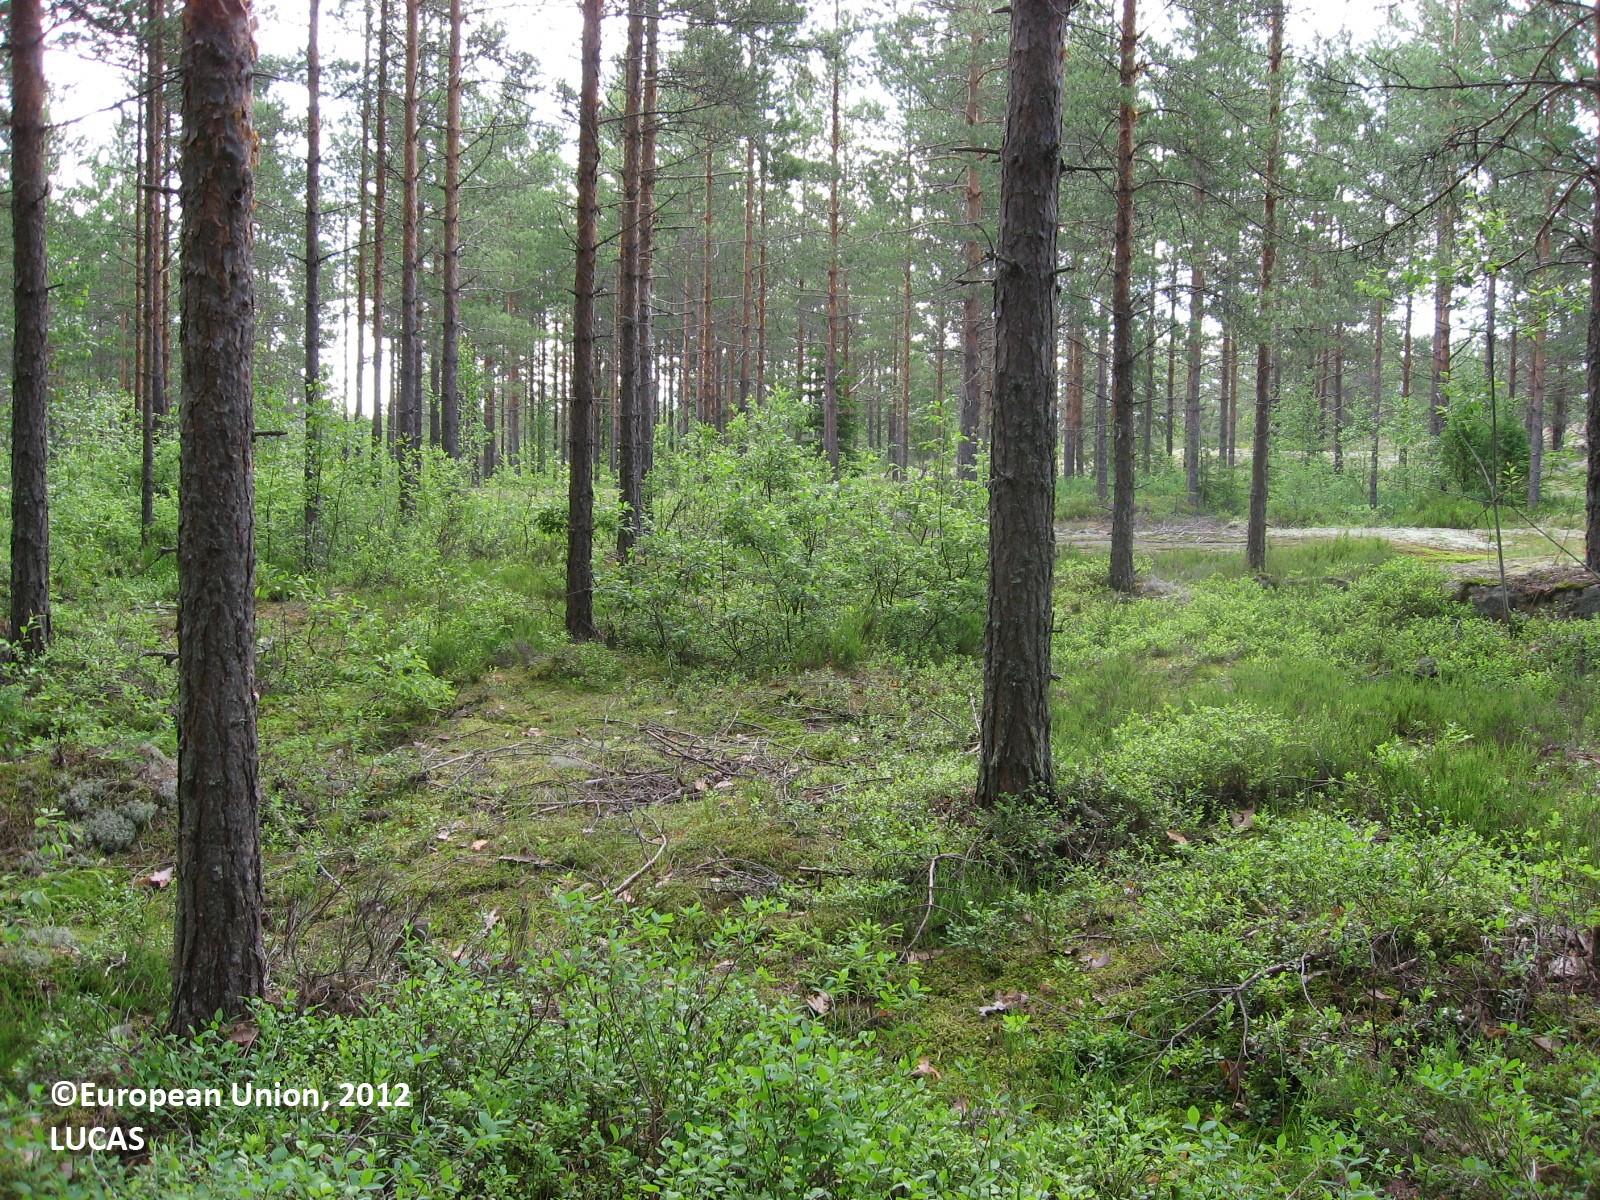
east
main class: Woodland
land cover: Pine dominated coniferous woodland
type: boreal forest
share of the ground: 50 - 75 %
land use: Forestry
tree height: > 5 m
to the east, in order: Pine dominated coniferous woodland; Pine dominated mixed woodland; Rock outcrops; Tracks; Rock outcrops; Pine dominated mixed woodland; Rock outcrops; Tracks; Rock outcrops; Other coniferous woodland
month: June
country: FI
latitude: 60.6559
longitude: 26.1894
